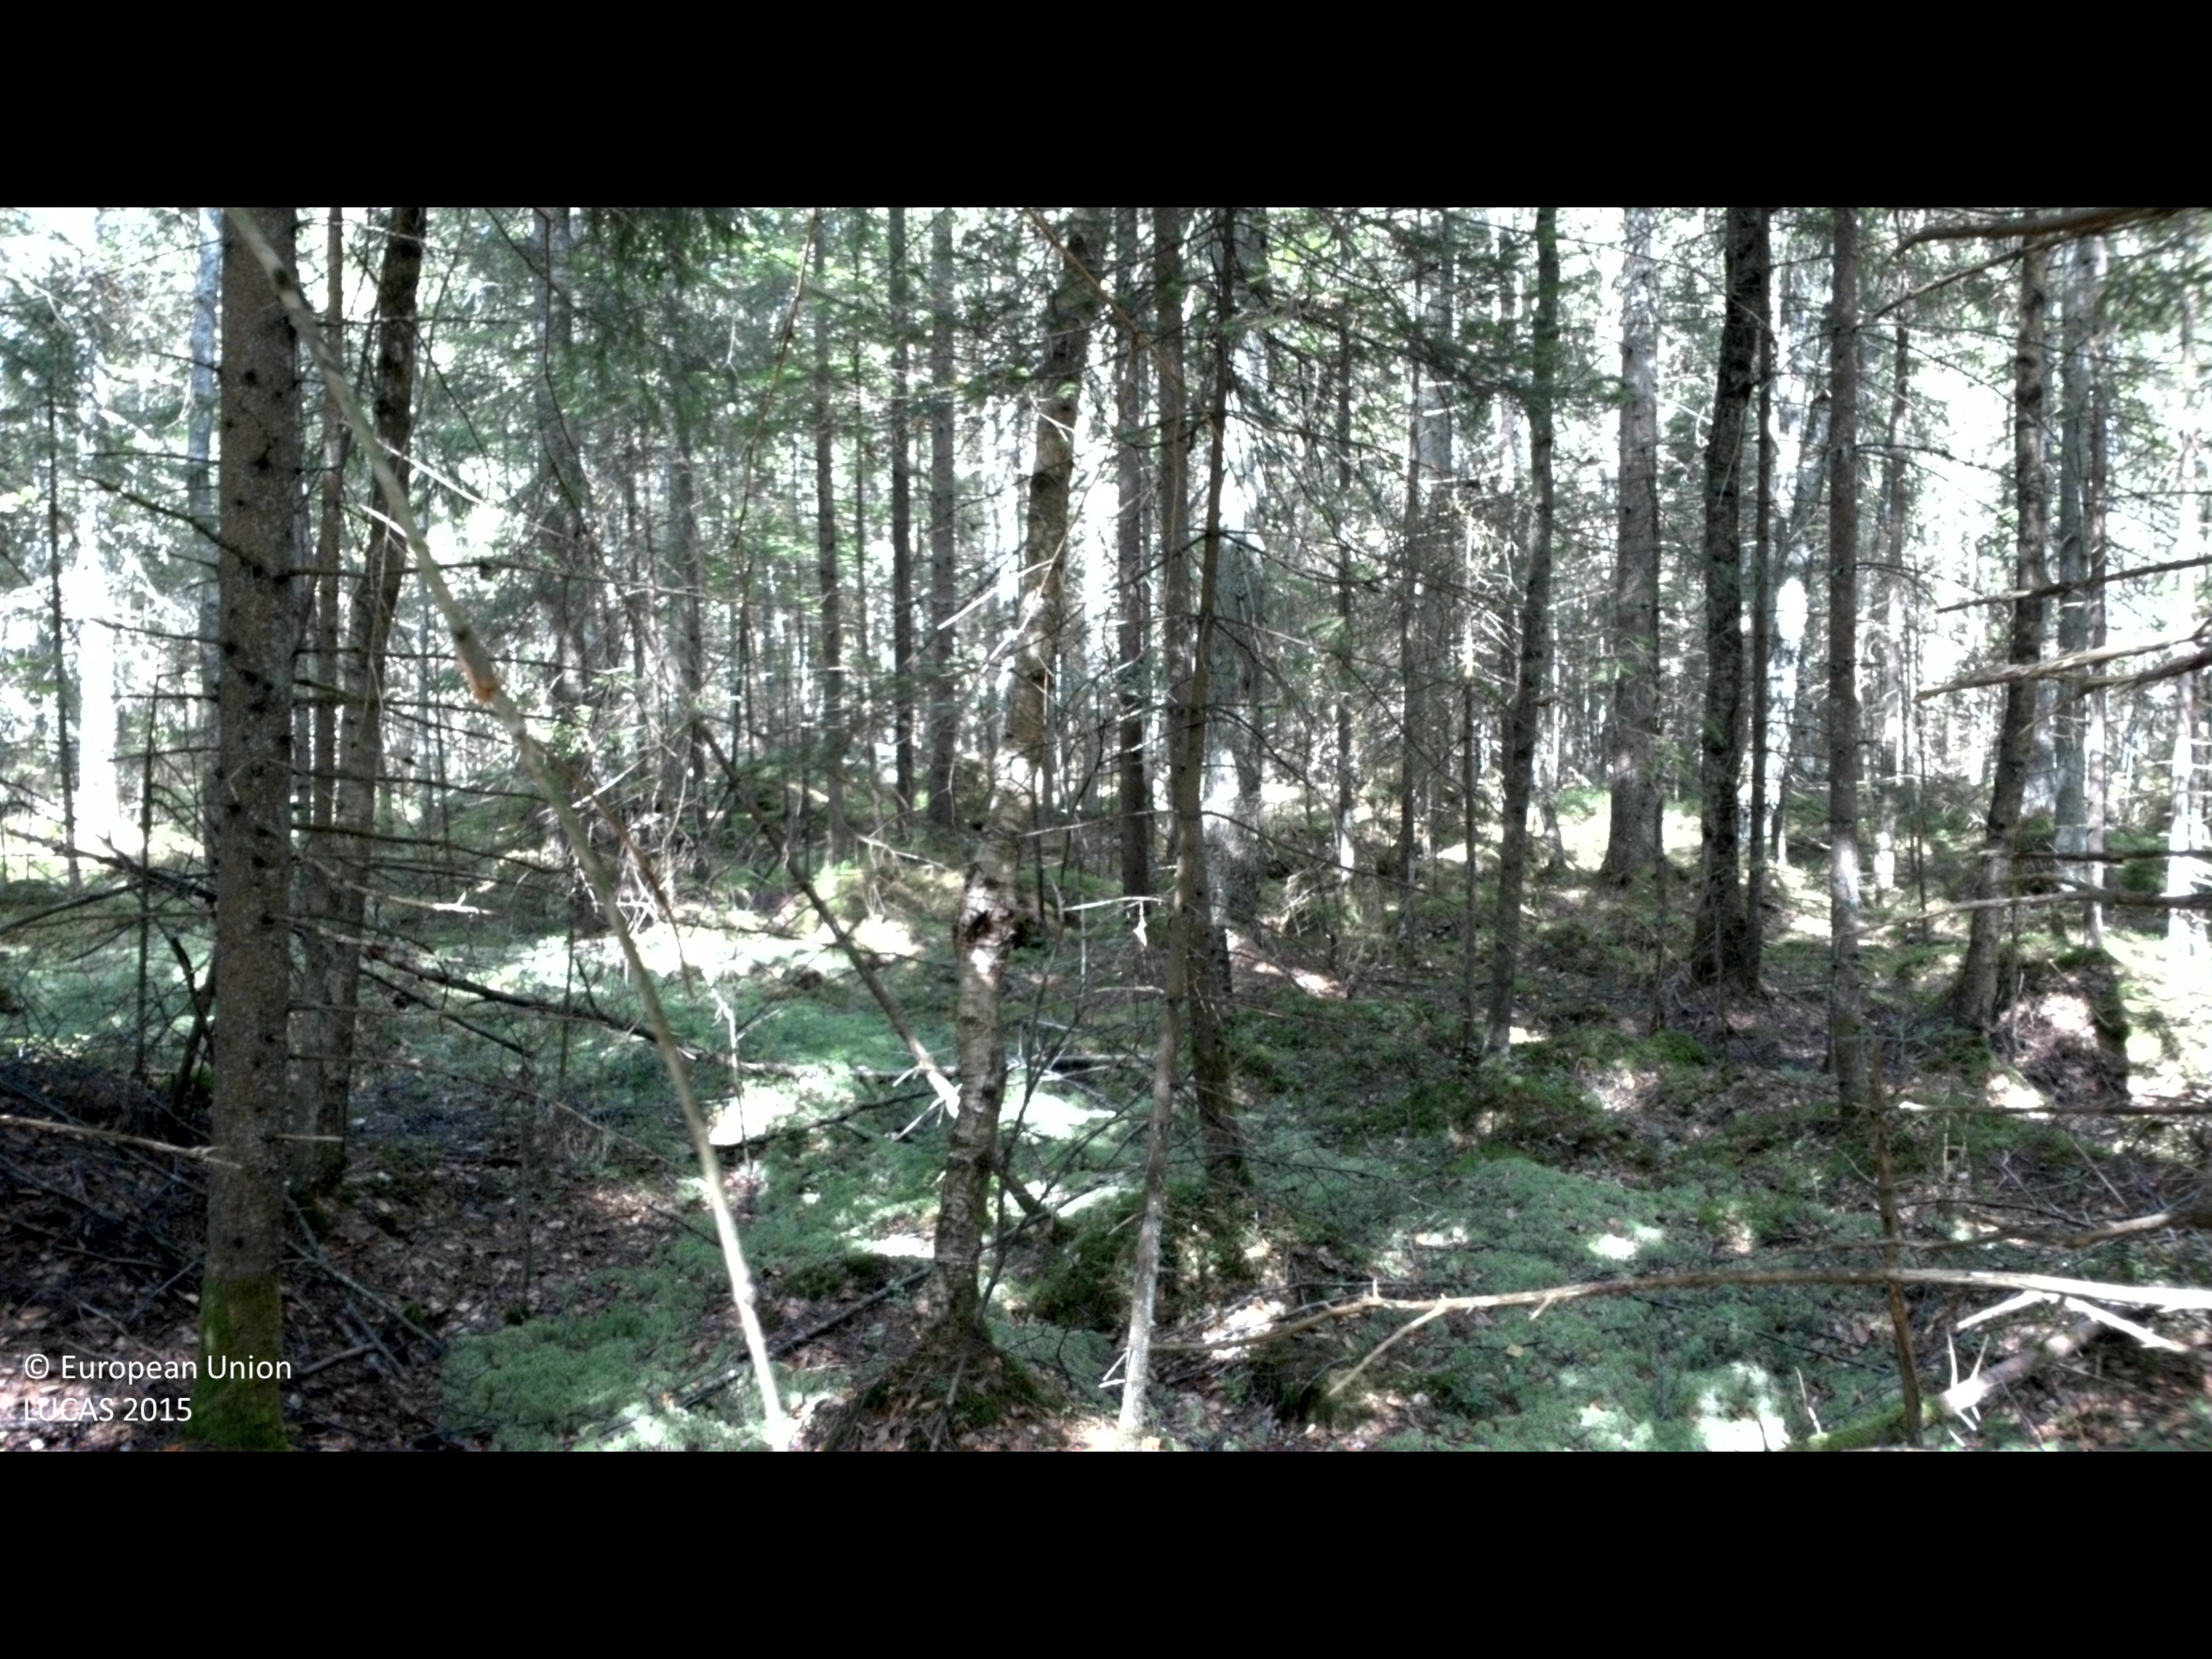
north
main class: Woodland
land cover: Spruce dominated coniferous woodland
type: boreal forest
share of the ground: > 75 %
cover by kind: coniferous forest trees 70 %, broadleaved forest trees 15 %, shrubs 5 %, herbaceous plants 5 %, lichens and mosses 5 %
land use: Forestry
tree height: > 5 m
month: August
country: SE
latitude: 56.2784
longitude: 14.7951
